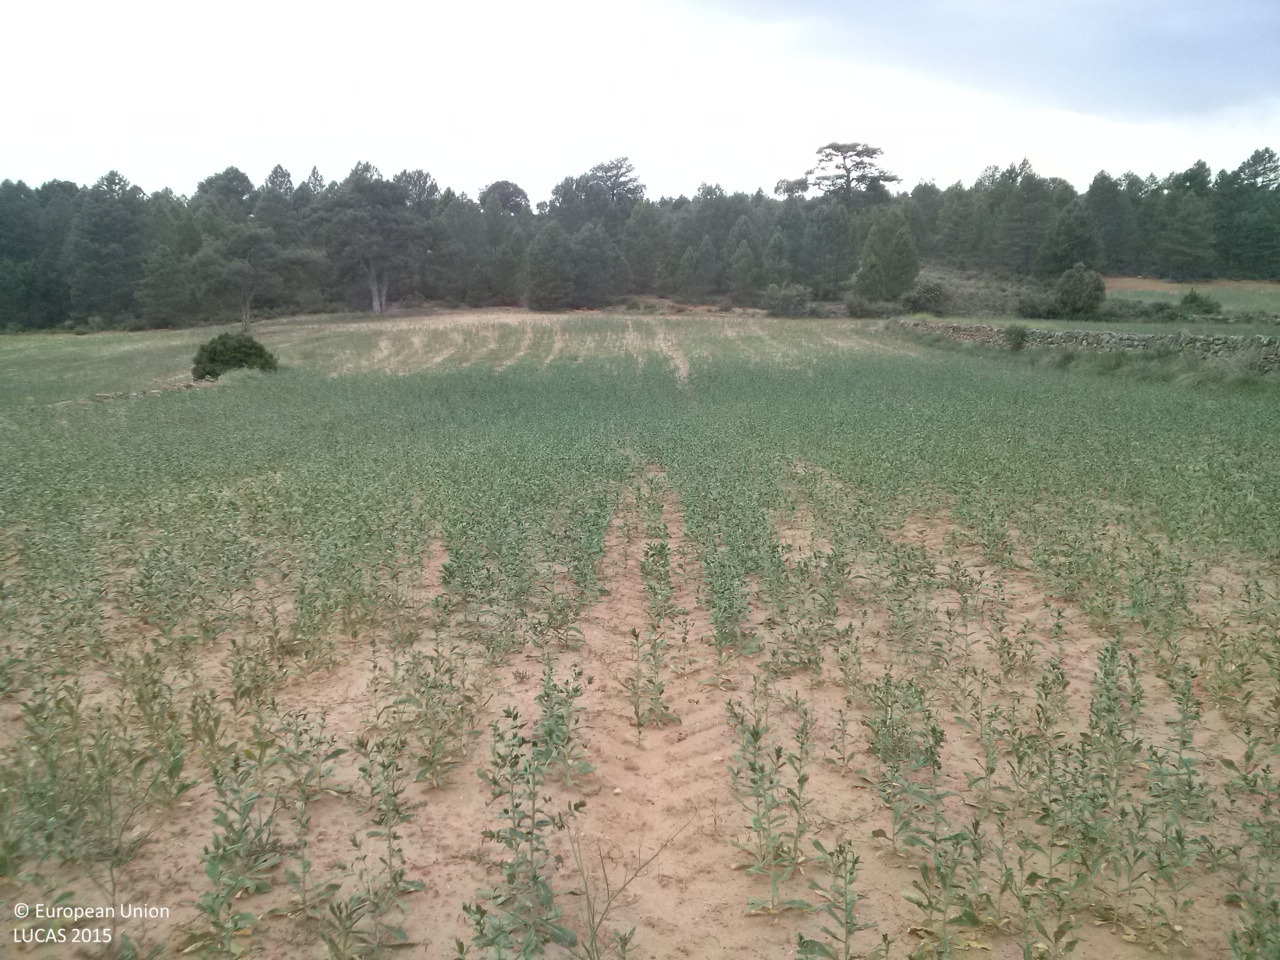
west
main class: Cropland
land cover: Other fibre and oleaginous crops
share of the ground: > 75 %
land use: Agriculture (excluding fallow land and kitchen gardens)
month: June
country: ES
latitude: 39.9629
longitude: -1.7297
